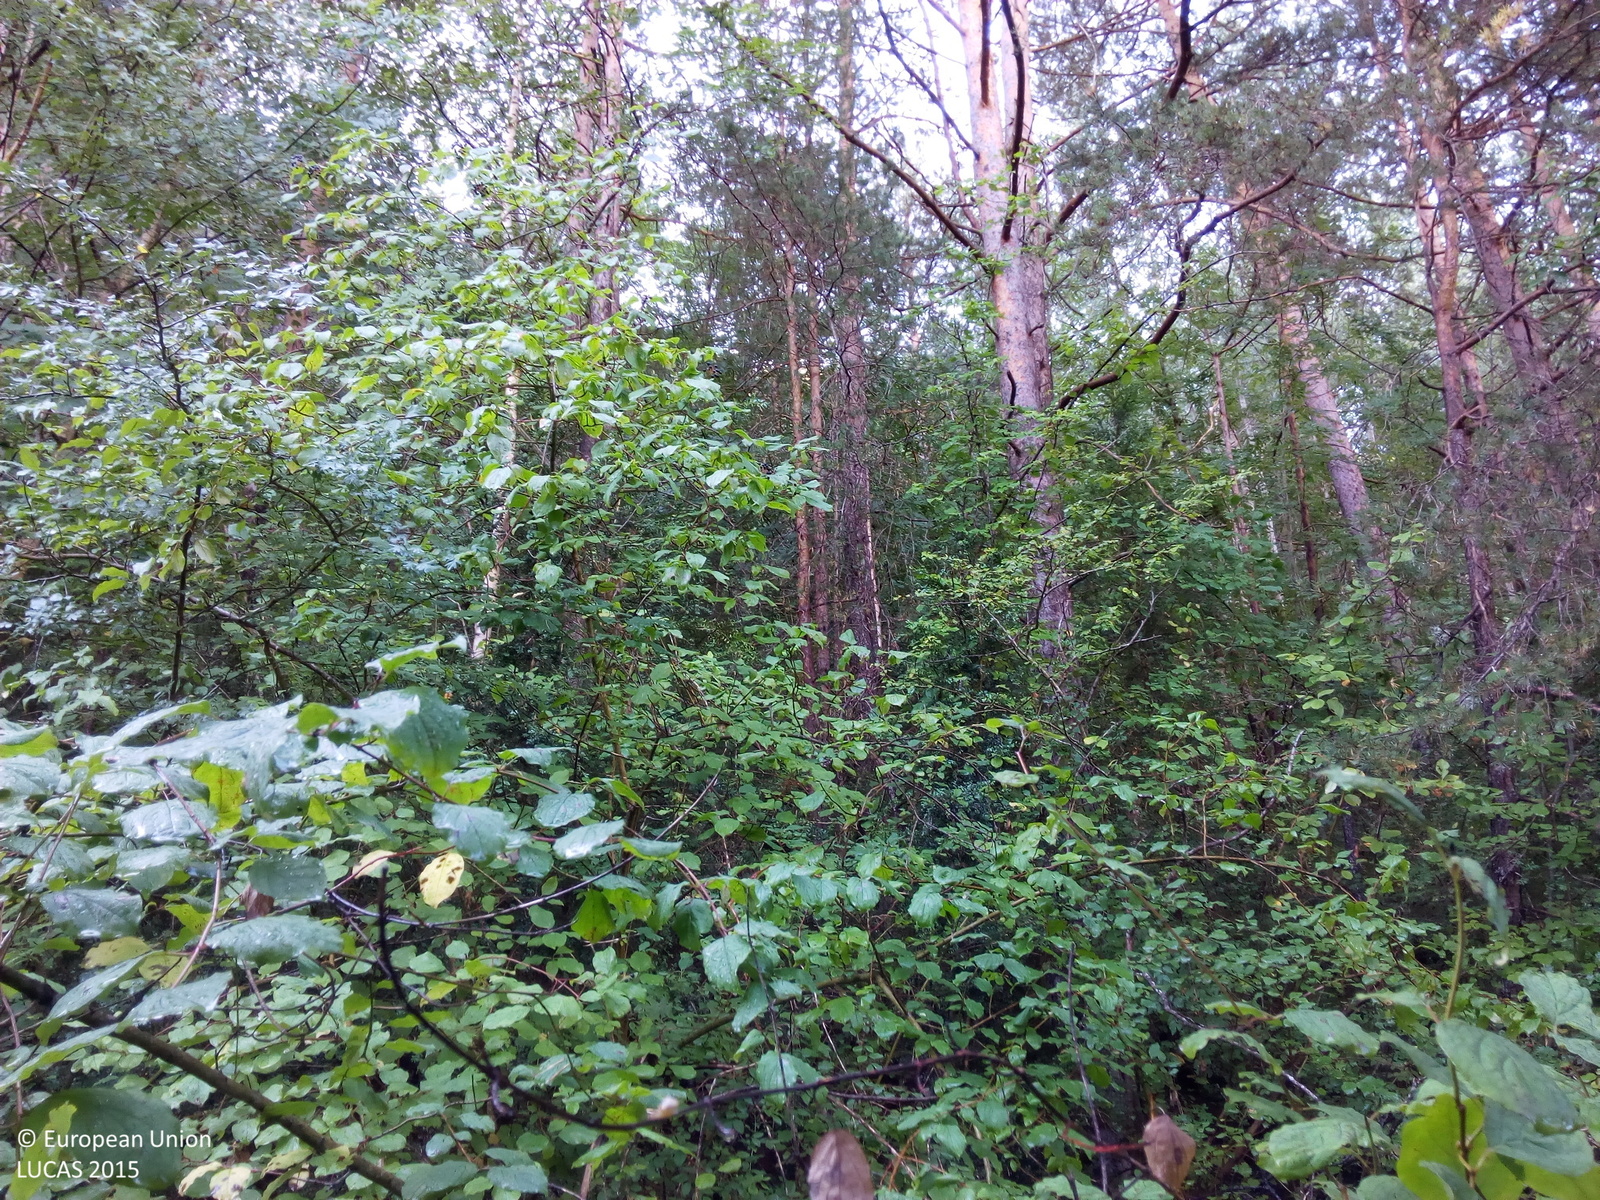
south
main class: Woodland
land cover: Pine dominated coniferous woodland
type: alpine coniferous forest
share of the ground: > 75 %
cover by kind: coniferous forest trees 100 %
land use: Semi-natural and natural areas not in use
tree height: > 5 m
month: September
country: ES
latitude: 42.5709
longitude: 0.3182
